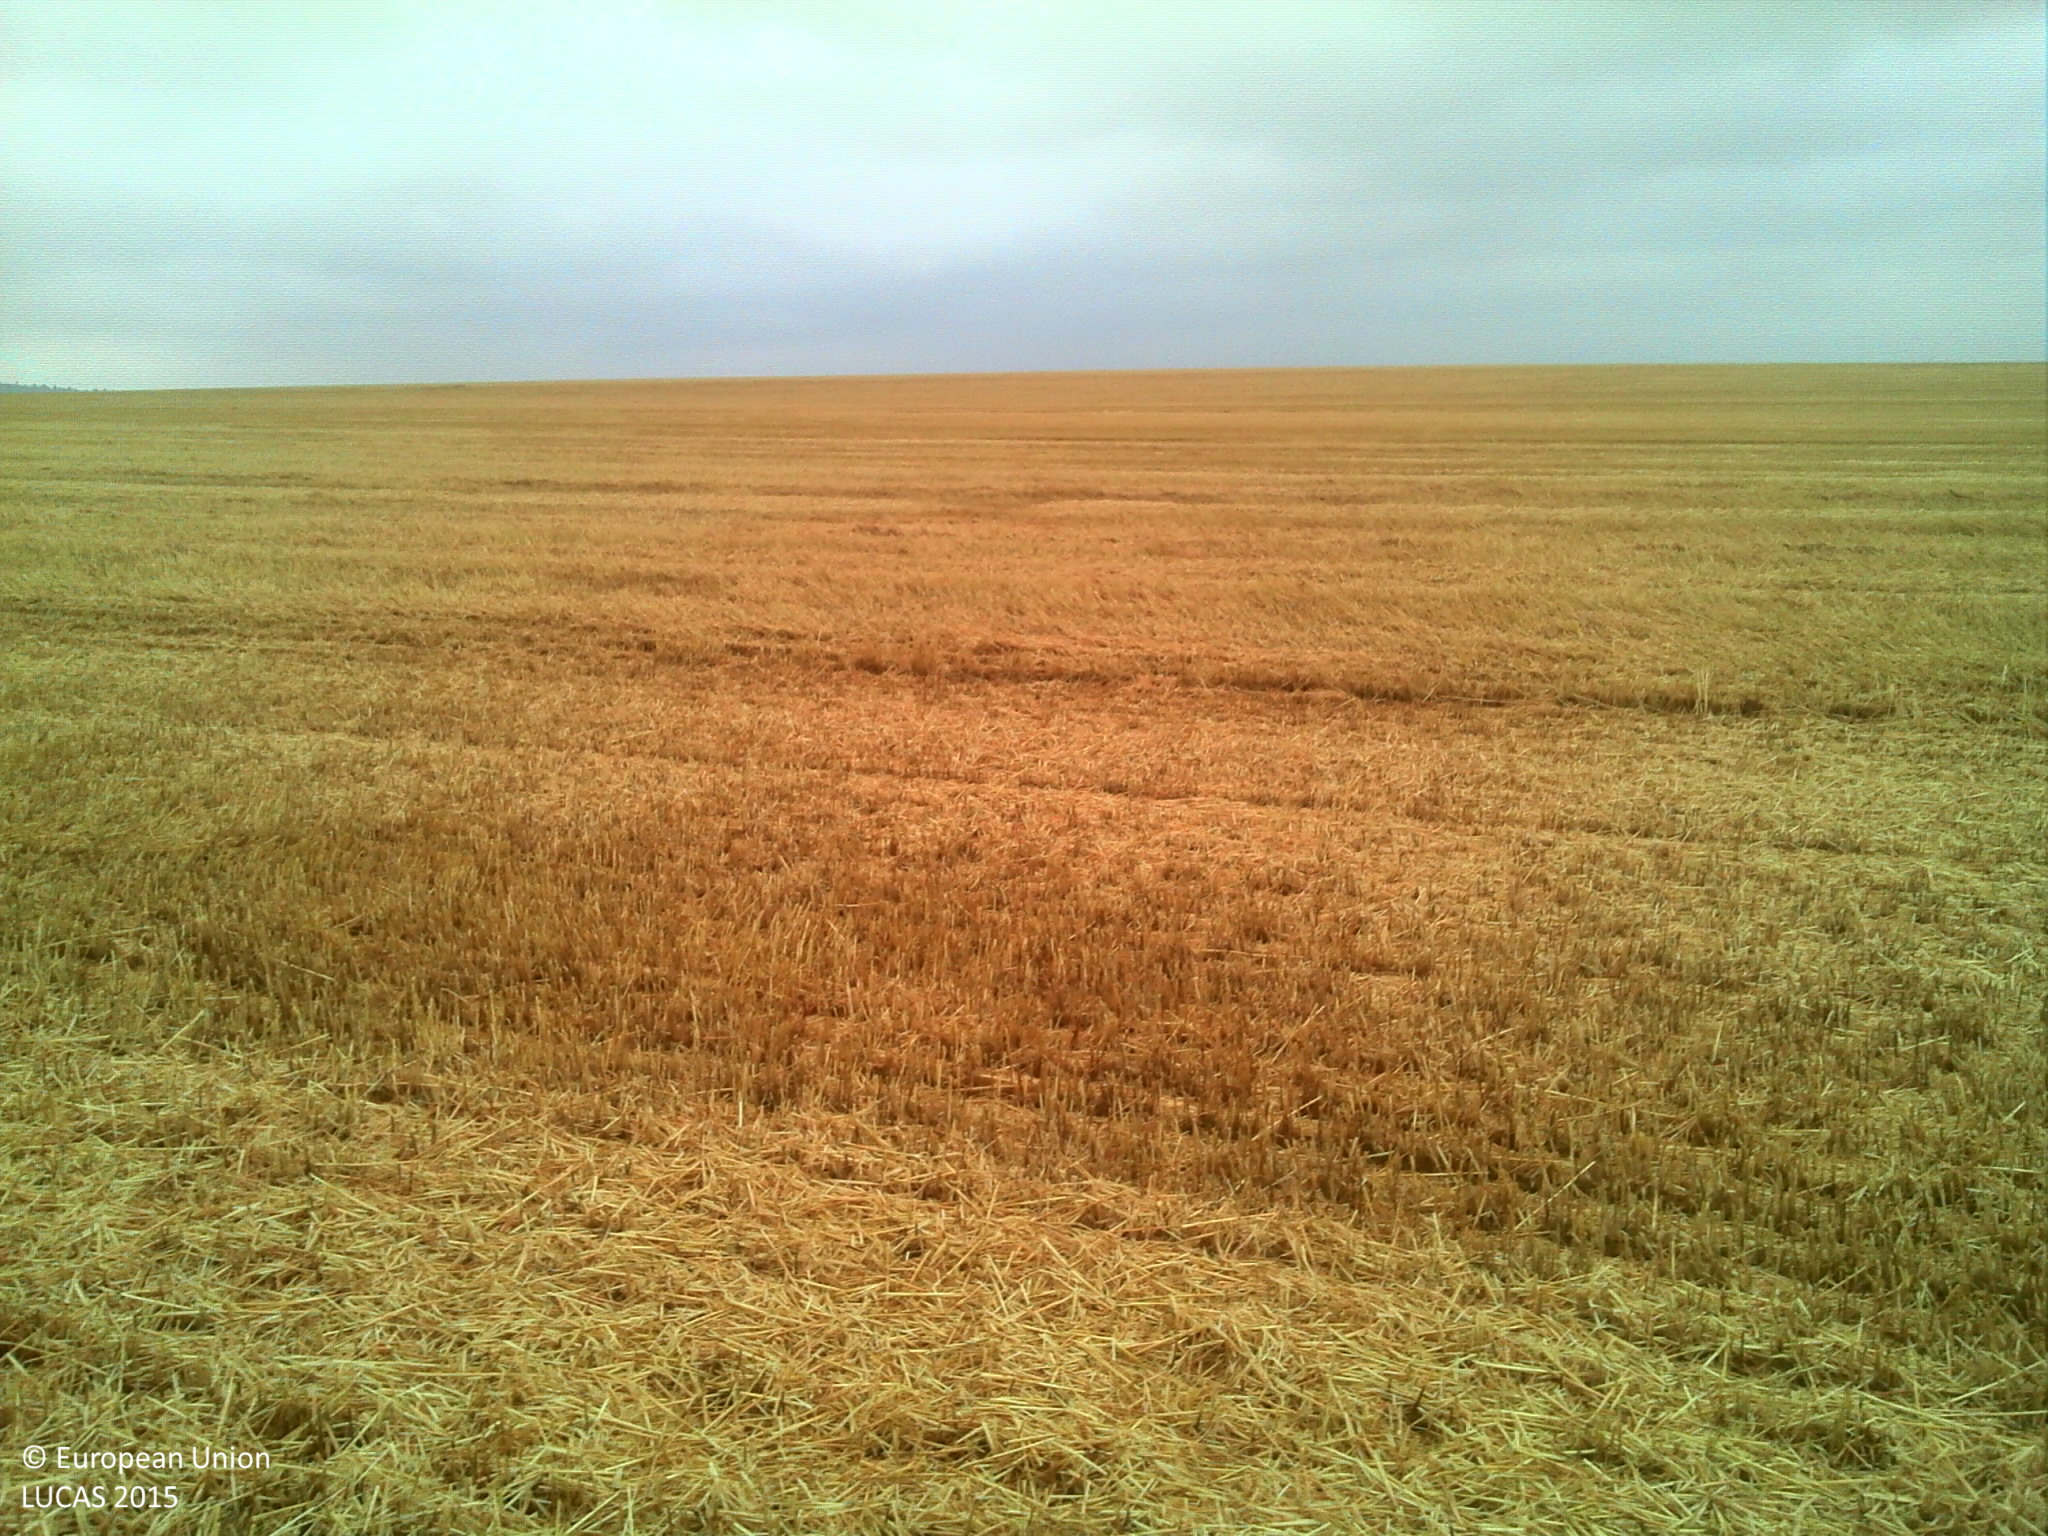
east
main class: Cropland
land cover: Common wheat
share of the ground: > 75 %
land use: Agriculture (excluding fallow land and kitchen gardens)
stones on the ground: < 10 %
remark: Harvested field
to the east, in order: Common wheat
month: July
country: FR
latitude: 48.7337
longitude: 3.7811
